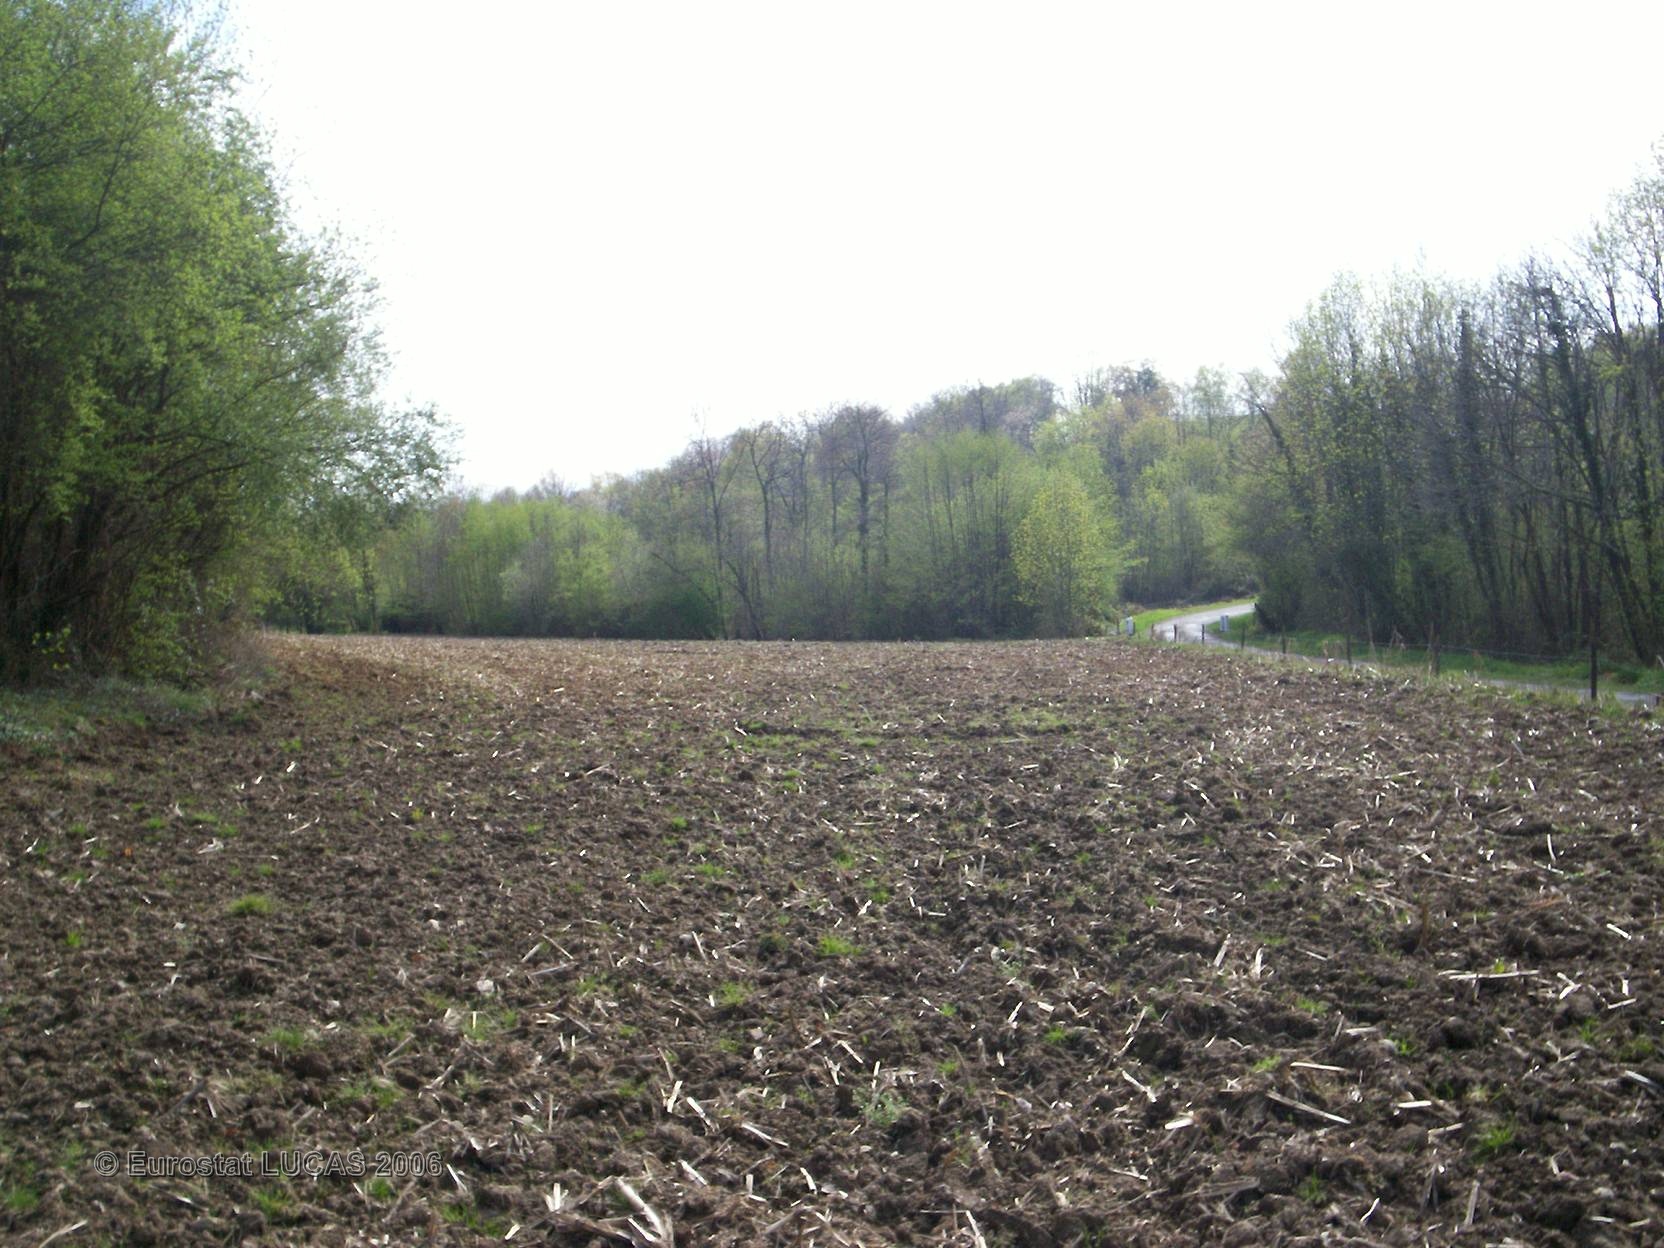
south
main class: Grassland
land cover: Grassland without tree/shrub cover
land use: Agriculture (excluding fallow land and kitchen gardens)
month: June
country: FR
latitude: 43.1635
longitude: -0.1264
